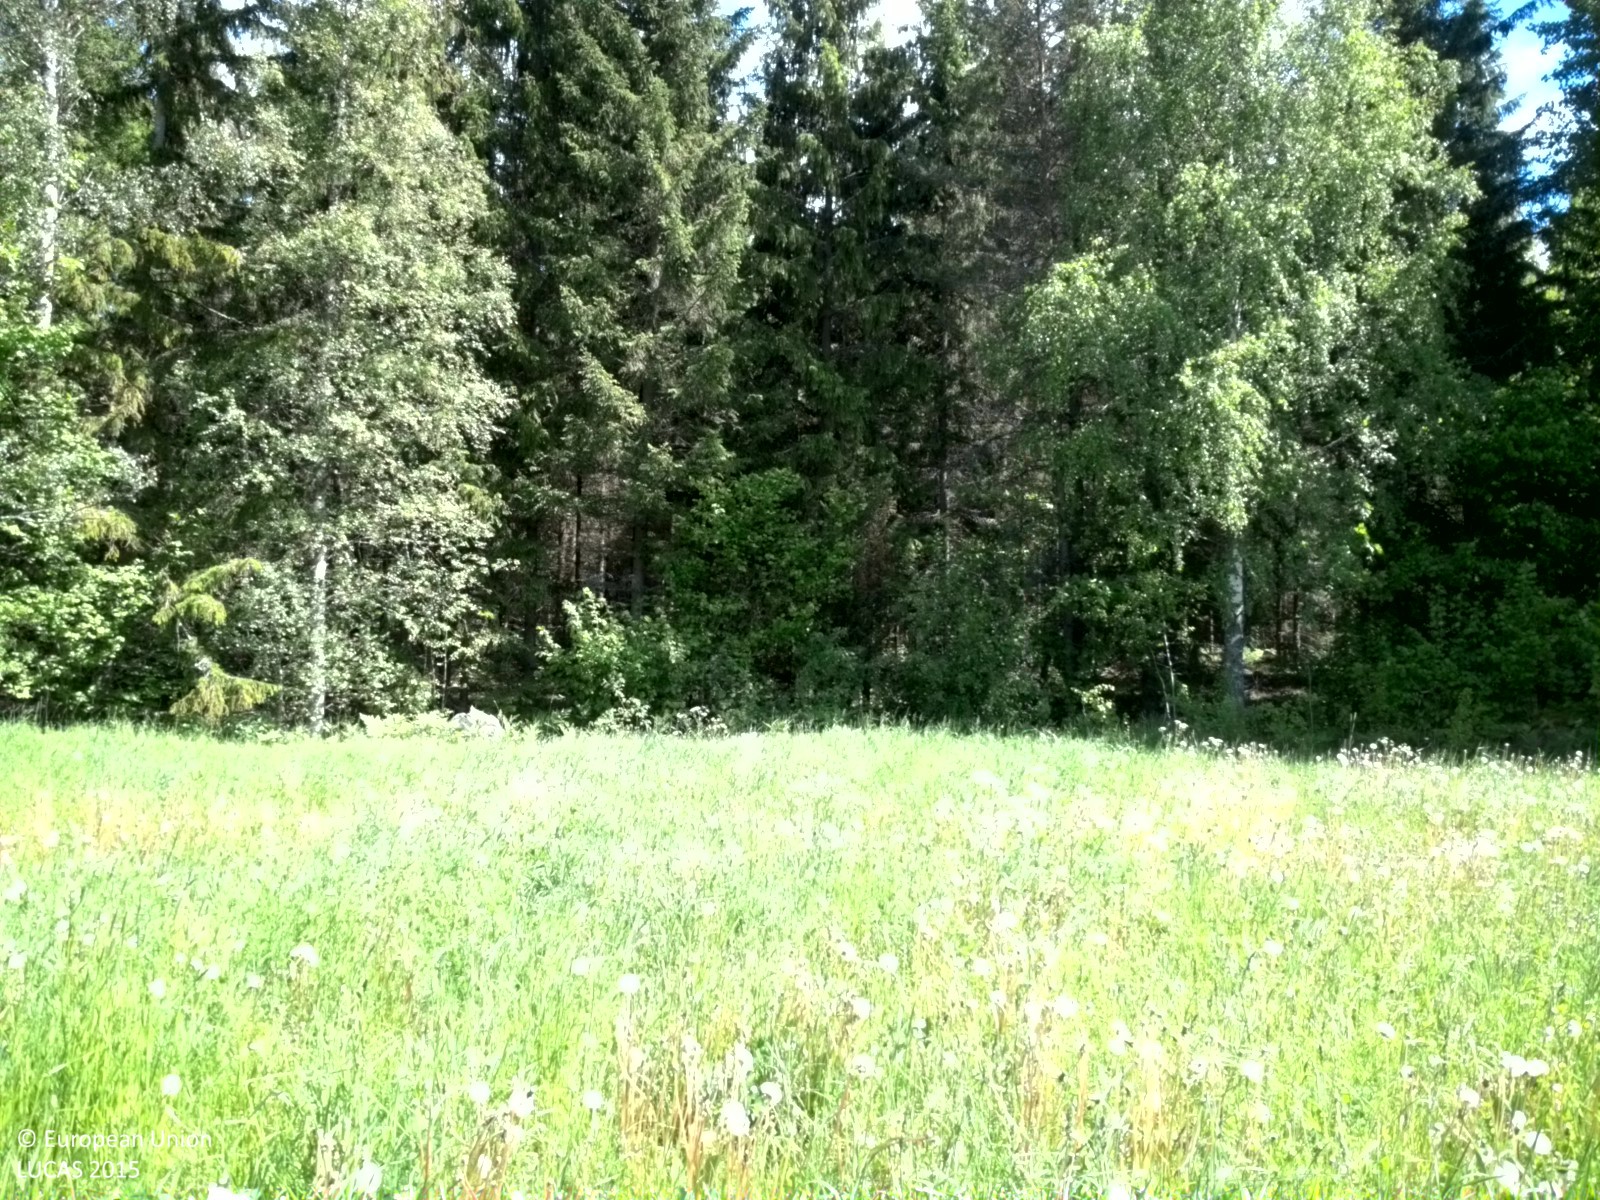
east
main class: Grassland
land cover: Grassland without tree/shrub cover
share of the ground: > 75 %
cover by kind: herbaceous plants 100 %
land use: Agriculture (excluding fallow land and kitchen gardens)
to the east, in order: Grassland without tree/shrub cover; Spruce dominated coniferous woodland; Paved roads, cycling and walking lanes; Spruce dominated coniferous woodland; Fences; Grassland without tree/shrub cover; Broadleaved woodland; Grassland with sparse tree/shrub cover; Grassland without tree/shrub cover; Spruce dominated mixed woodland
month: June
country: SE
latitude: 60.2335
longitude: 17.8484
